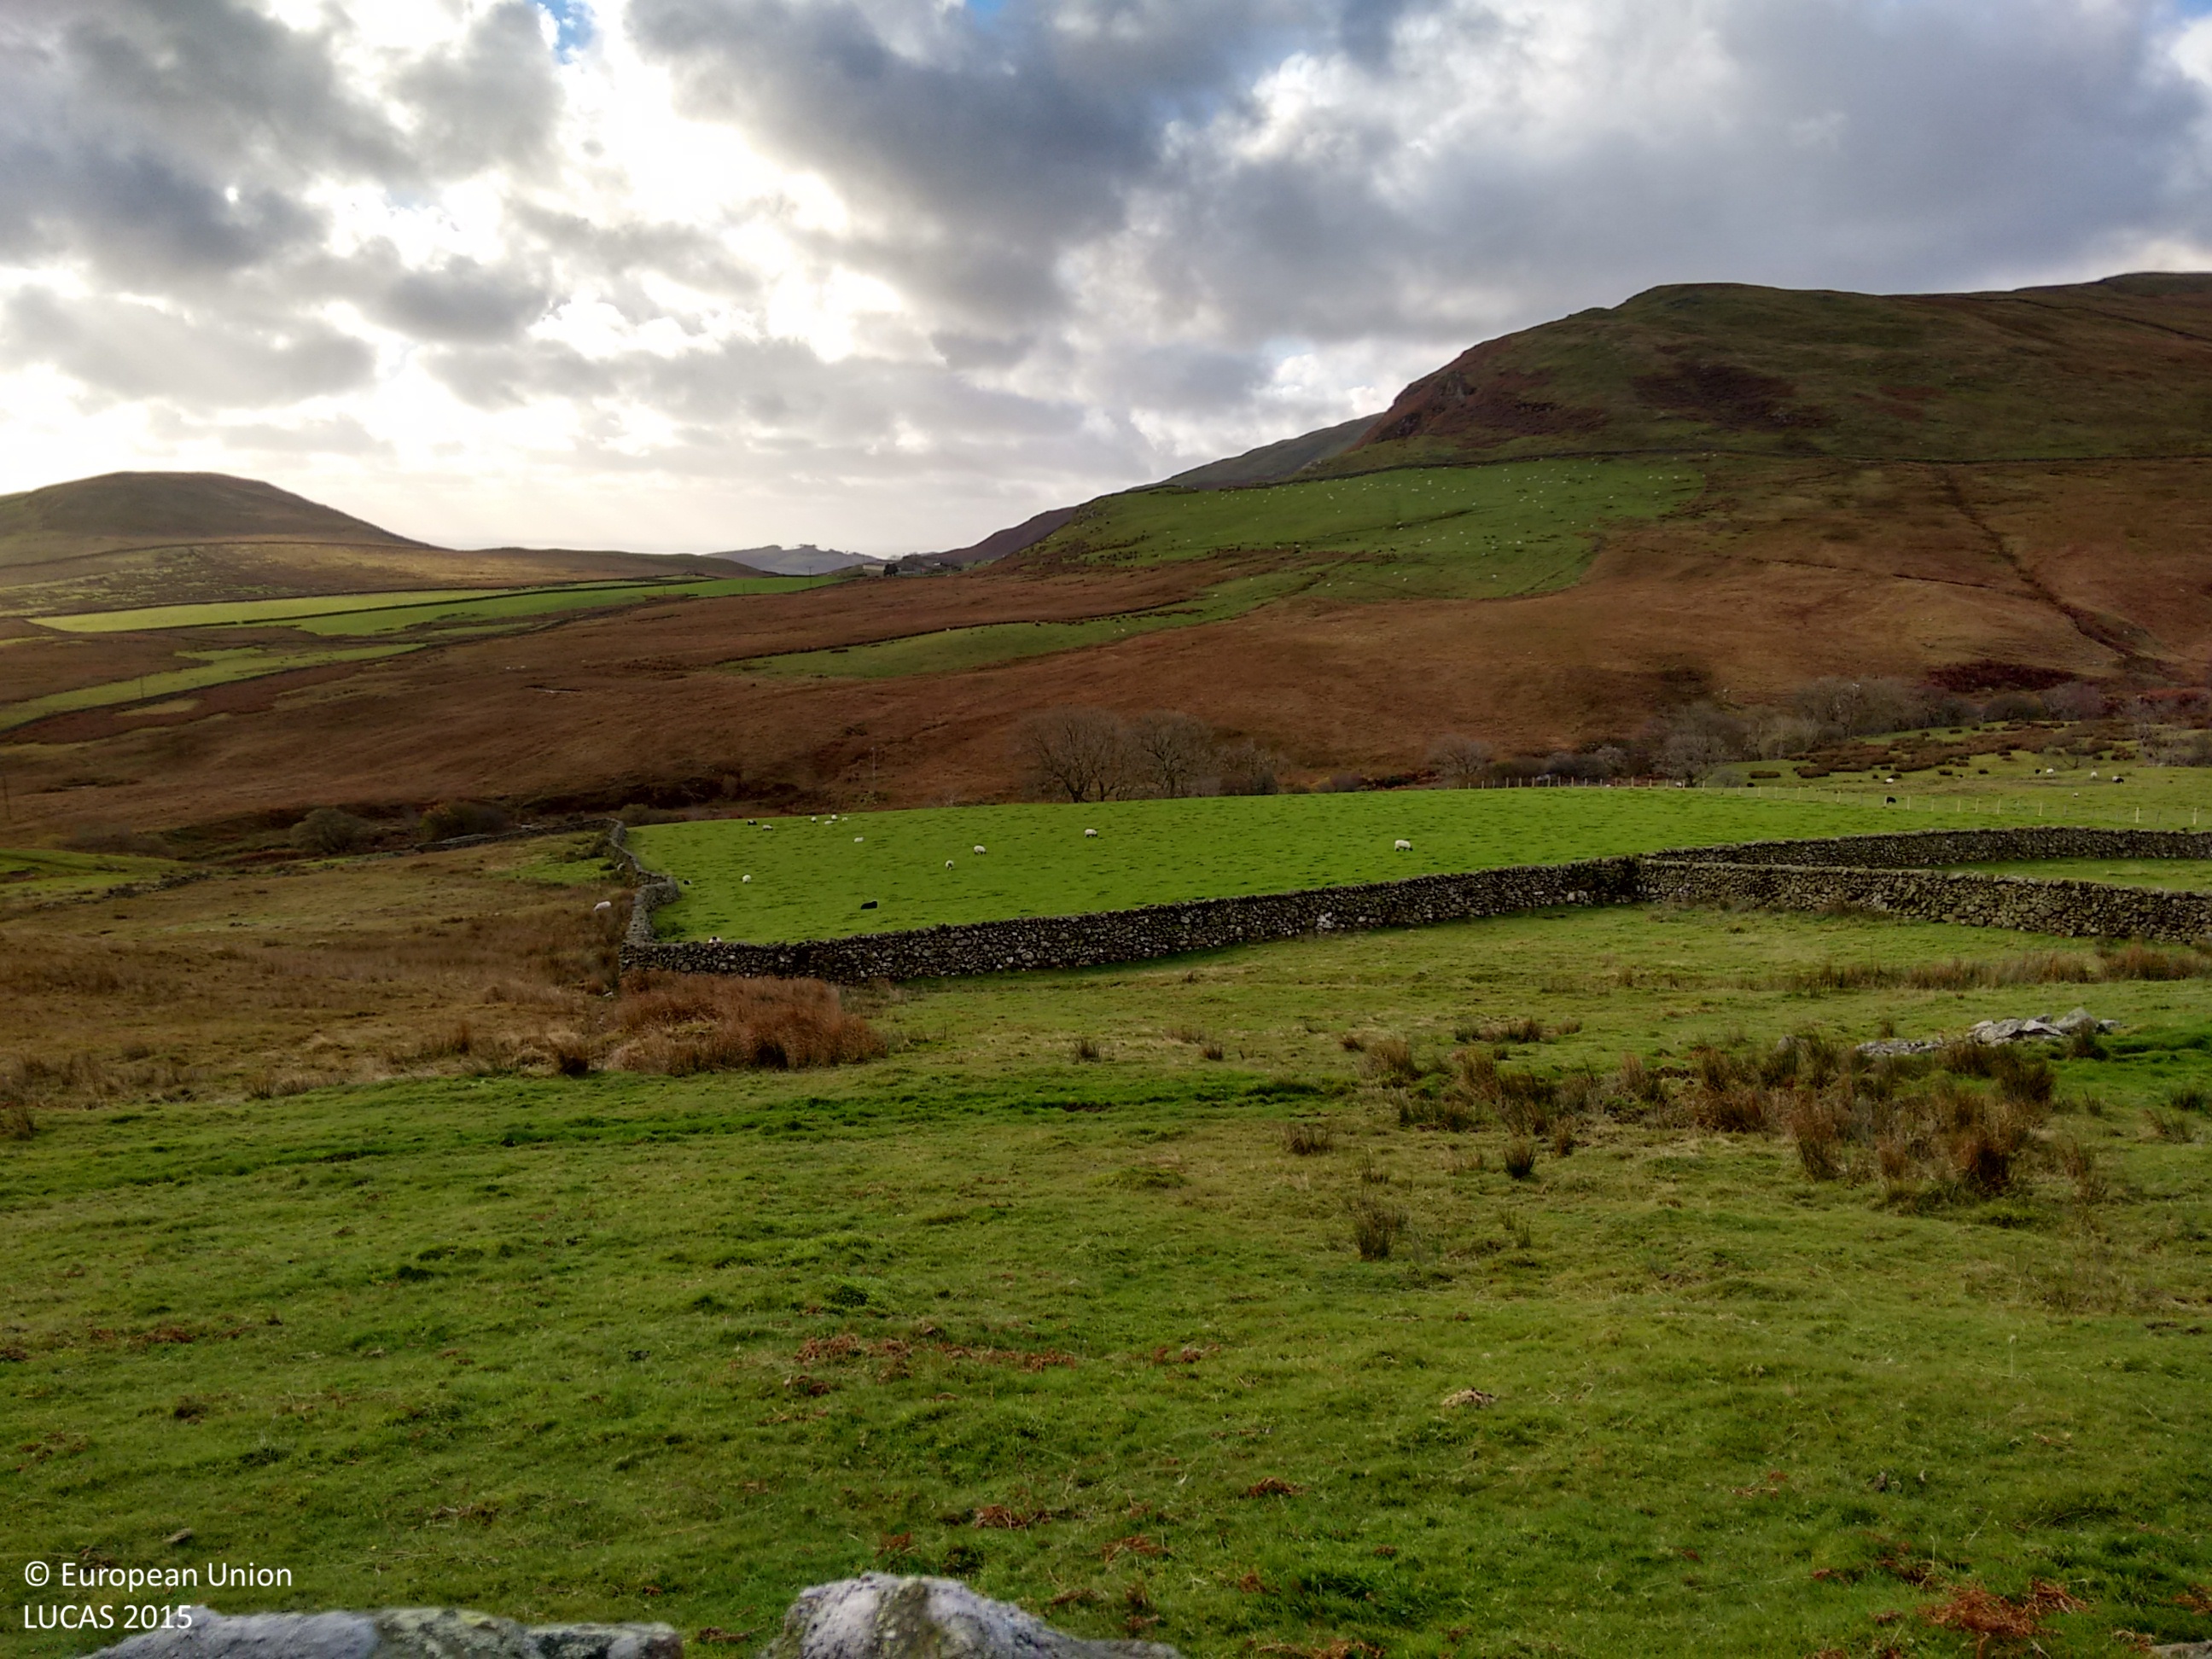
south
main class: Grassland
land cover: Grassland without tree/shrub cover
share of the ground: > 75 %
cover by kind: herbaceous plants 100 %
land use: Agriculture (excluding fallow land and kitchen gardens)
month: November
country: GB
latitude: 54.2899
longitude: -3.2745
